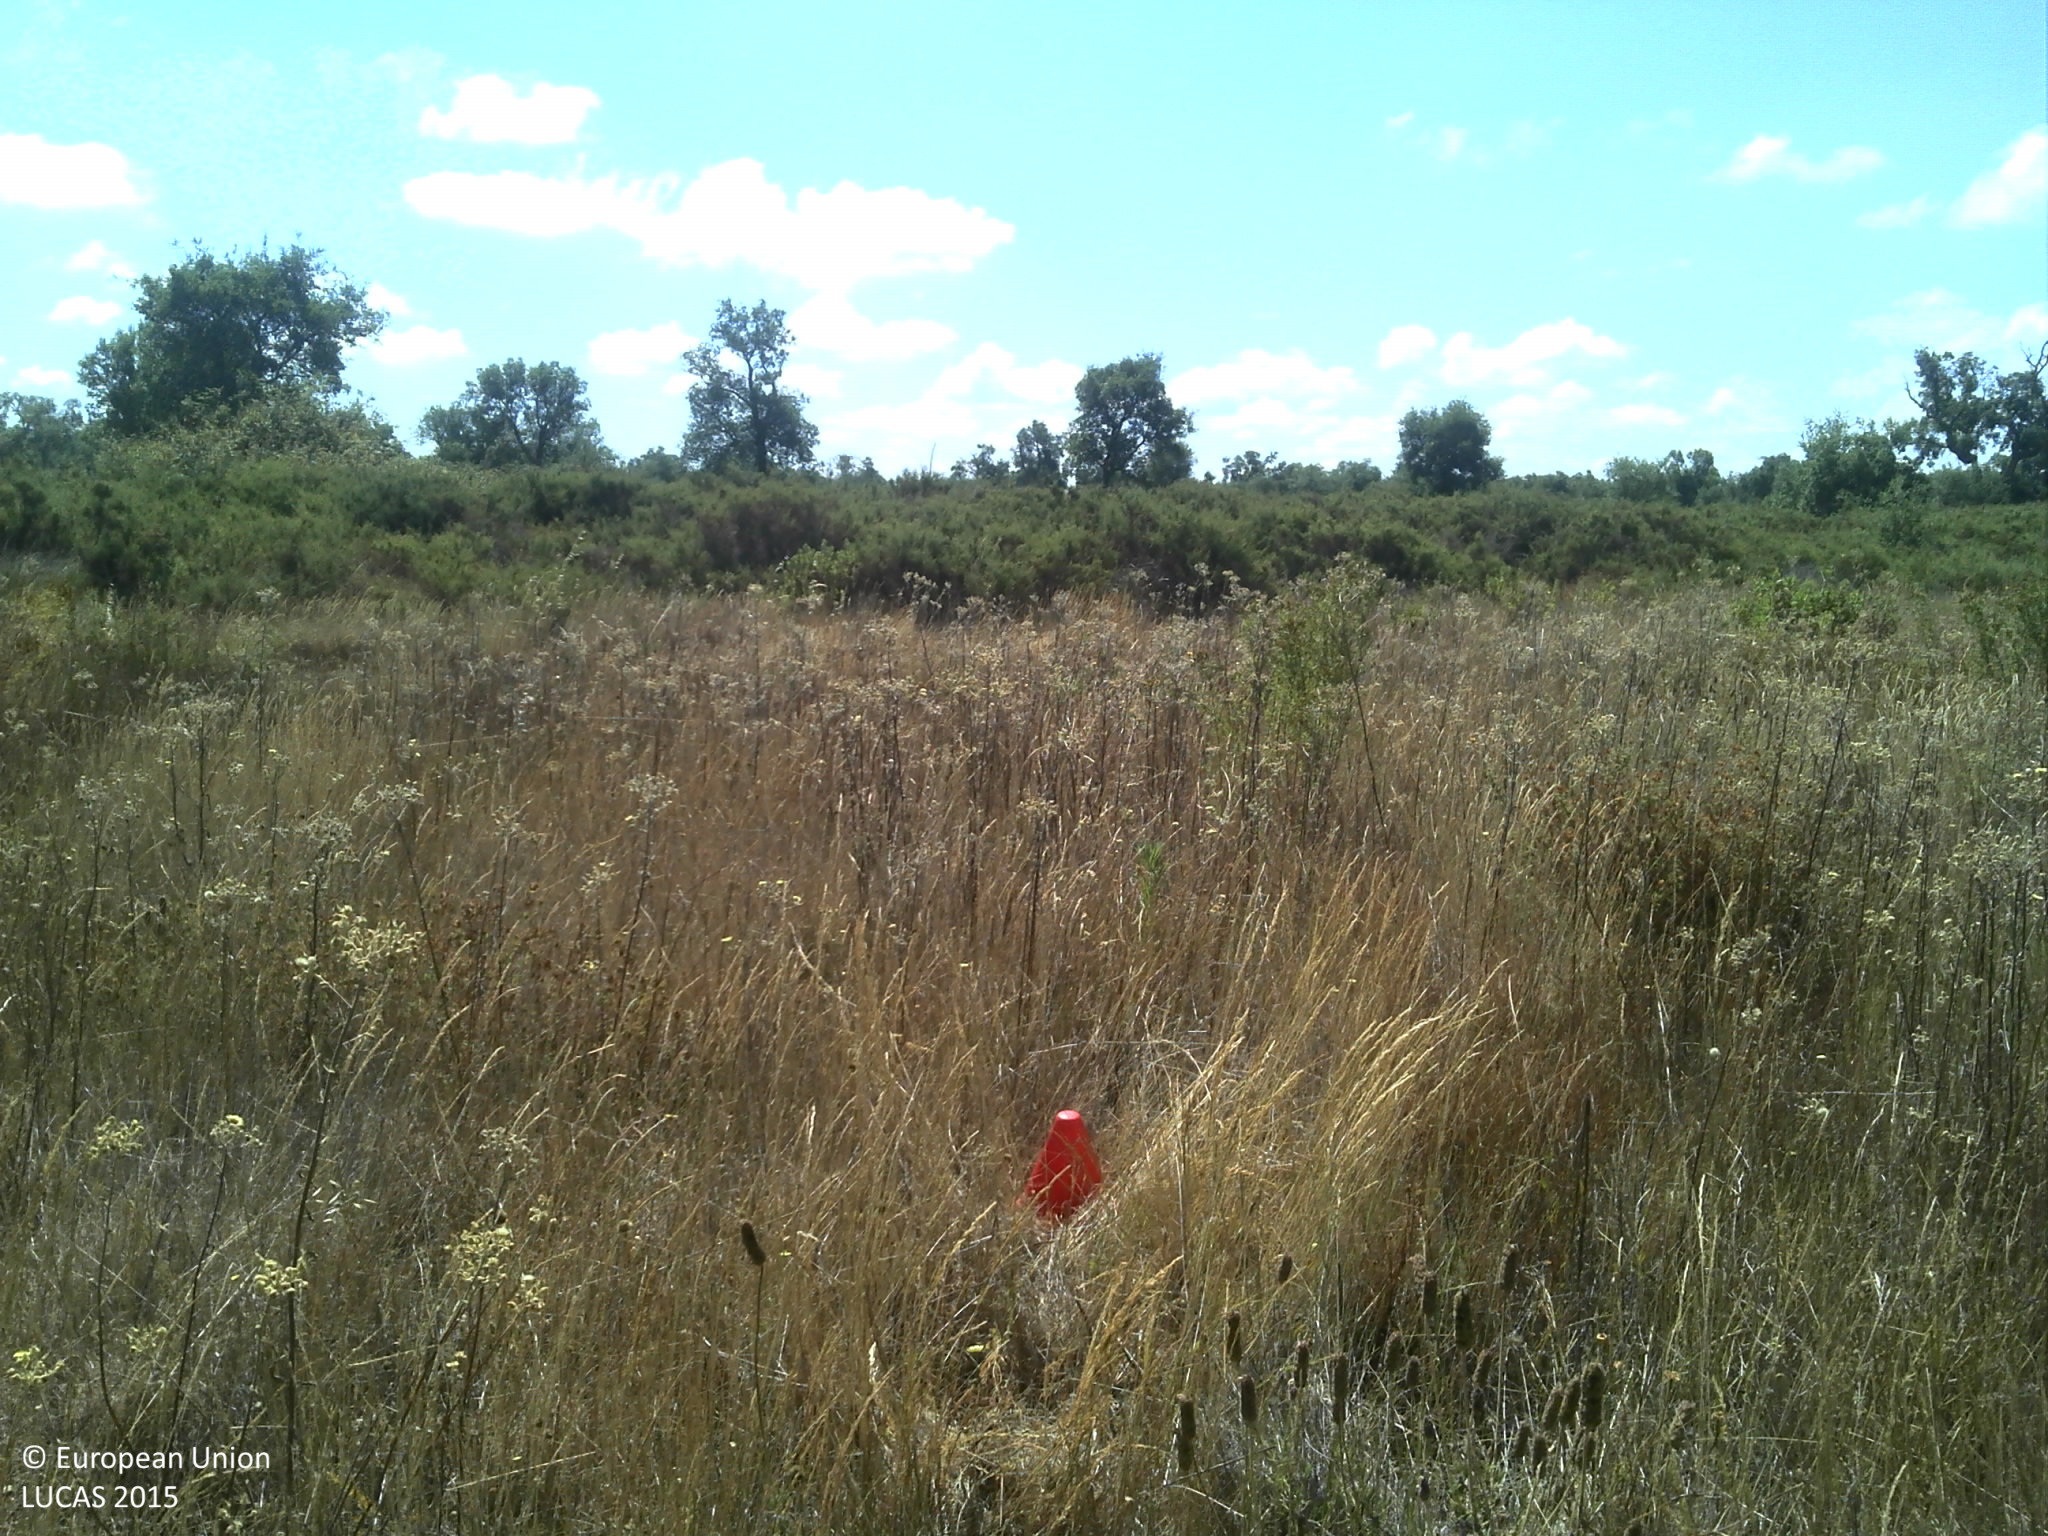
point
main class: Grassland
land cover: Grassland without tree/shrub cover
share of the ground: 50 - 75 %
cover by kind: herbaceous plants 75 %, consolidated bare surface 25 %
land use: Agriculture (excluding fallow land and kitchen gardens)
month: June
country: PT
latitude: 39.3182
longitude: -8.2374
